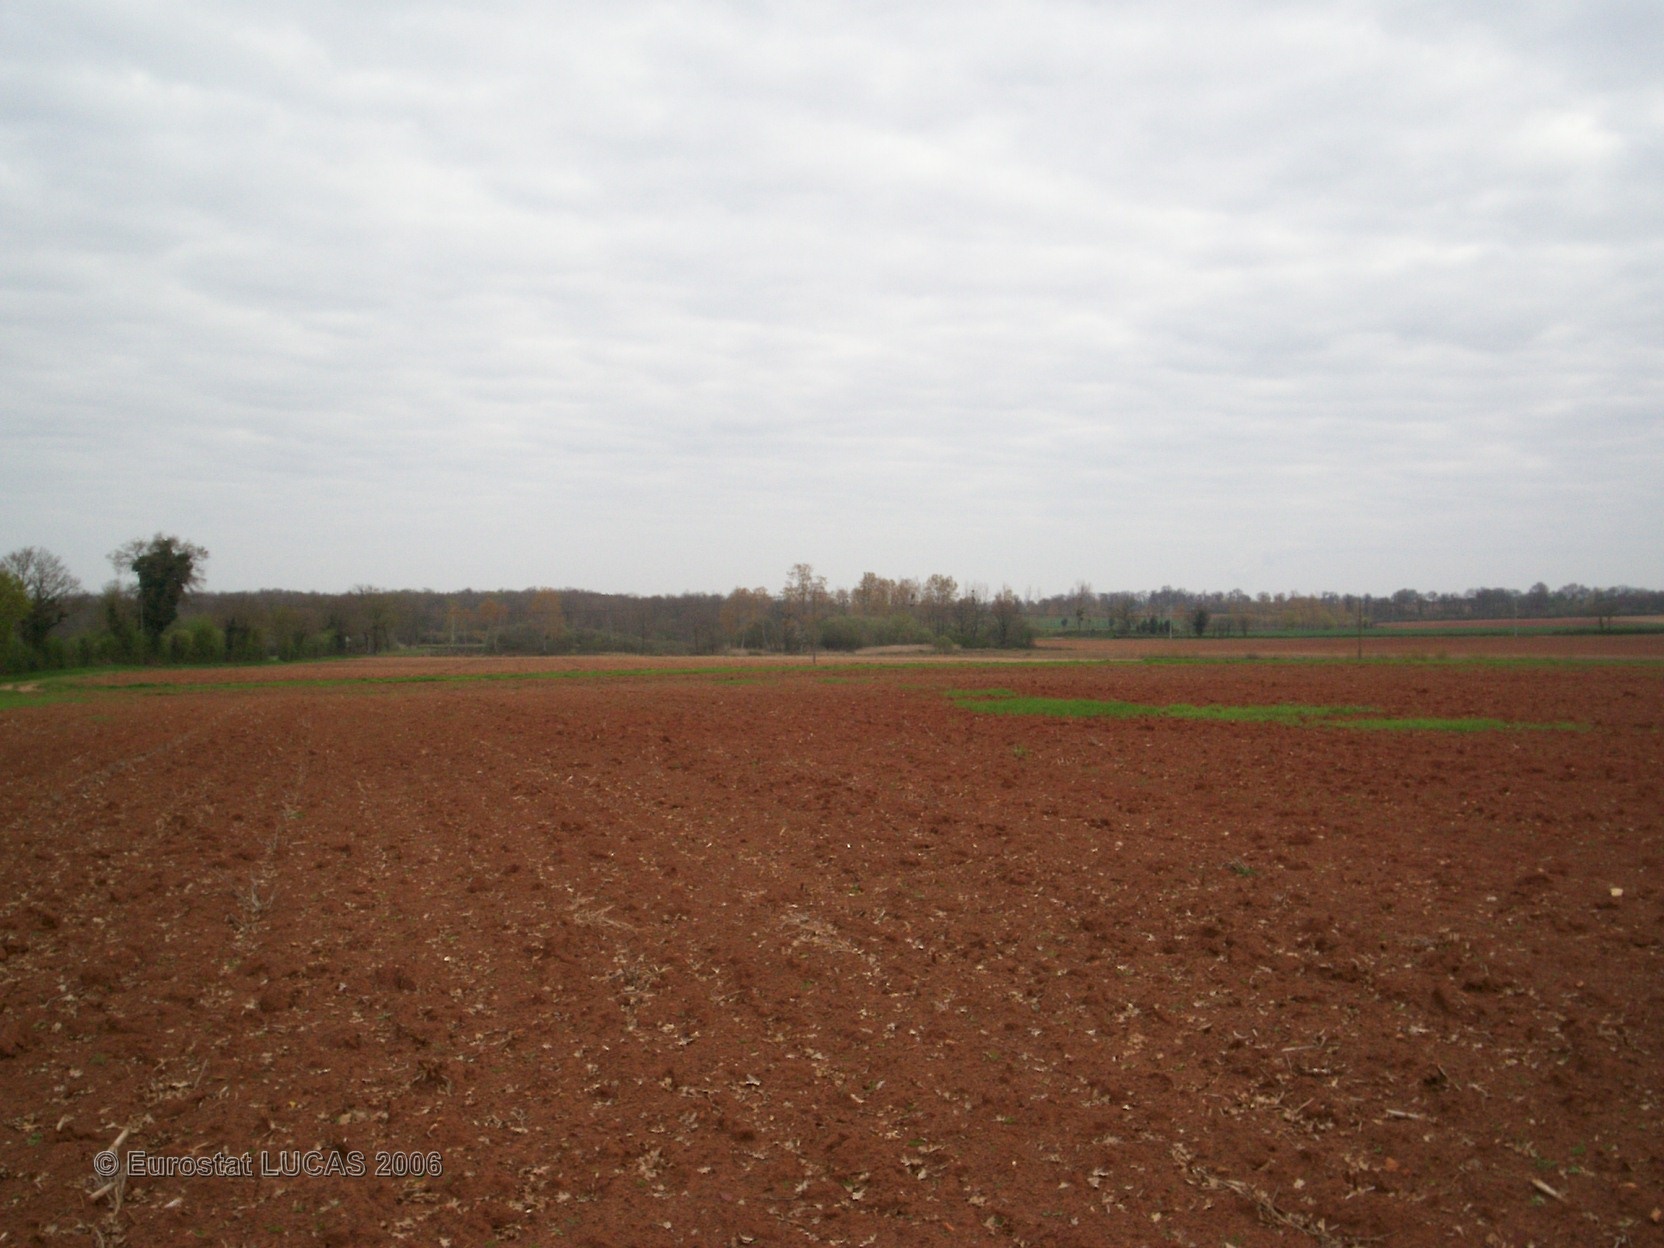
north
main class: Cropland
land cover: Maize
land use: Agriculture (excluding fallow land and kitchen gardens)
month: May
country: FR
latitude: 46.1313
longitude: 0.5490
